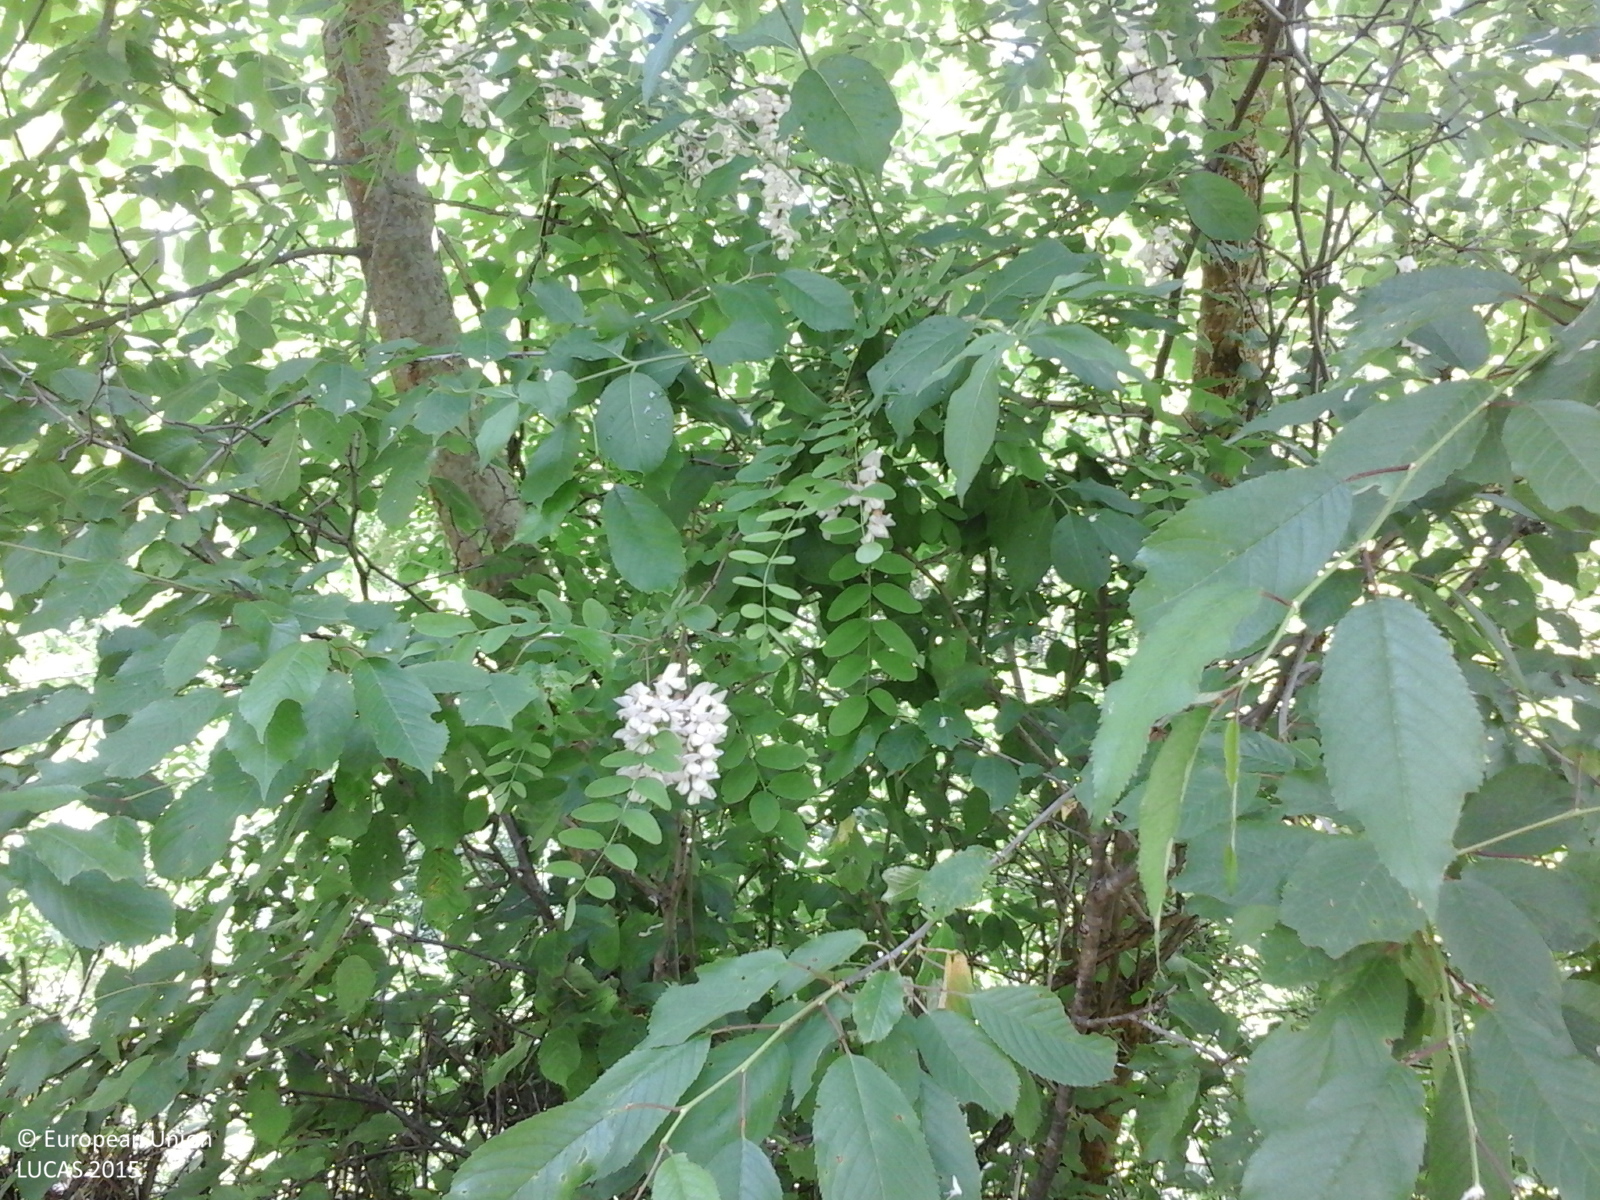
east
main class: Woodland
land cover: Broadleaved woodland
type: beech forest
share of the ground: > 75 %
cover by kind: broadleaved forest trees 90 %, shrubs 5 %, herbaceous plants 5 %
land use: Forestry
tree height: > 5 m
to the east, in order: Broadleaved woodland; Fences; Tracks; Fences; Other fruit trees and berries; Fences; Rivers and streams; Other fruit trees and berries; Broadleaved woodland
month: May
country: RO
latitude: 45.2338
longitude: 26.2032
